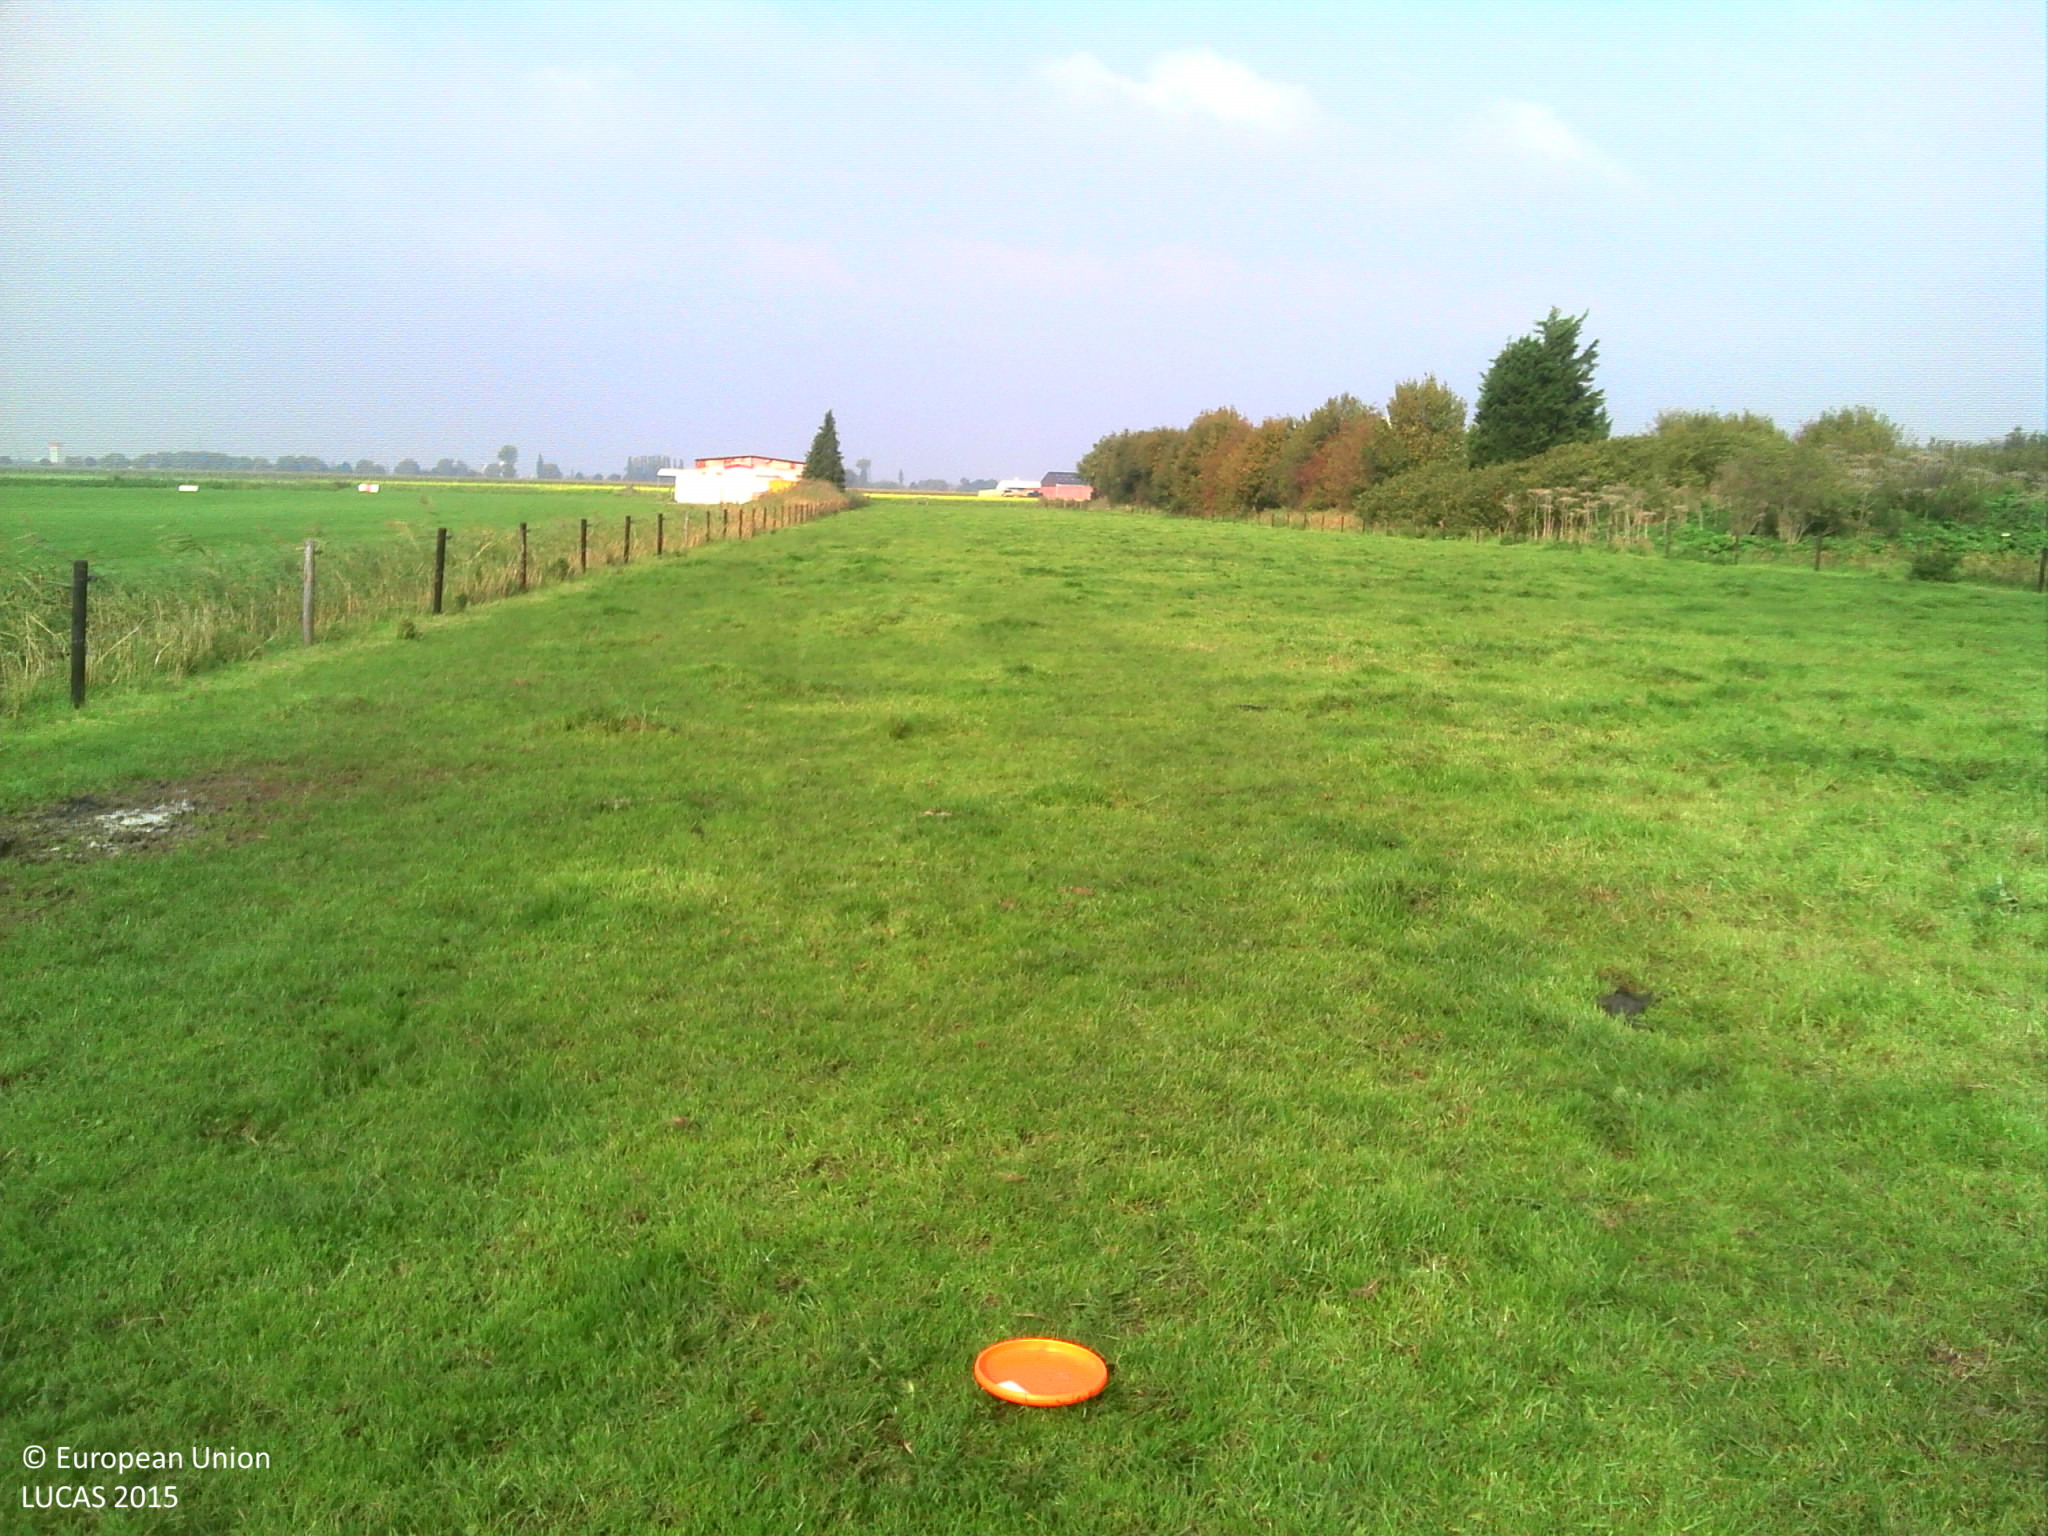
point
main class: Grassland
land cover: Grassland without tree/shrub cover
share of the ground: > 75 %
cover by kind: herbaceous plants 100 %
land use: Agriculture (excluding fallow land and kitchen gardens)
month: October
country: BE
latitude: 51.3077
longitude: 4.3865
